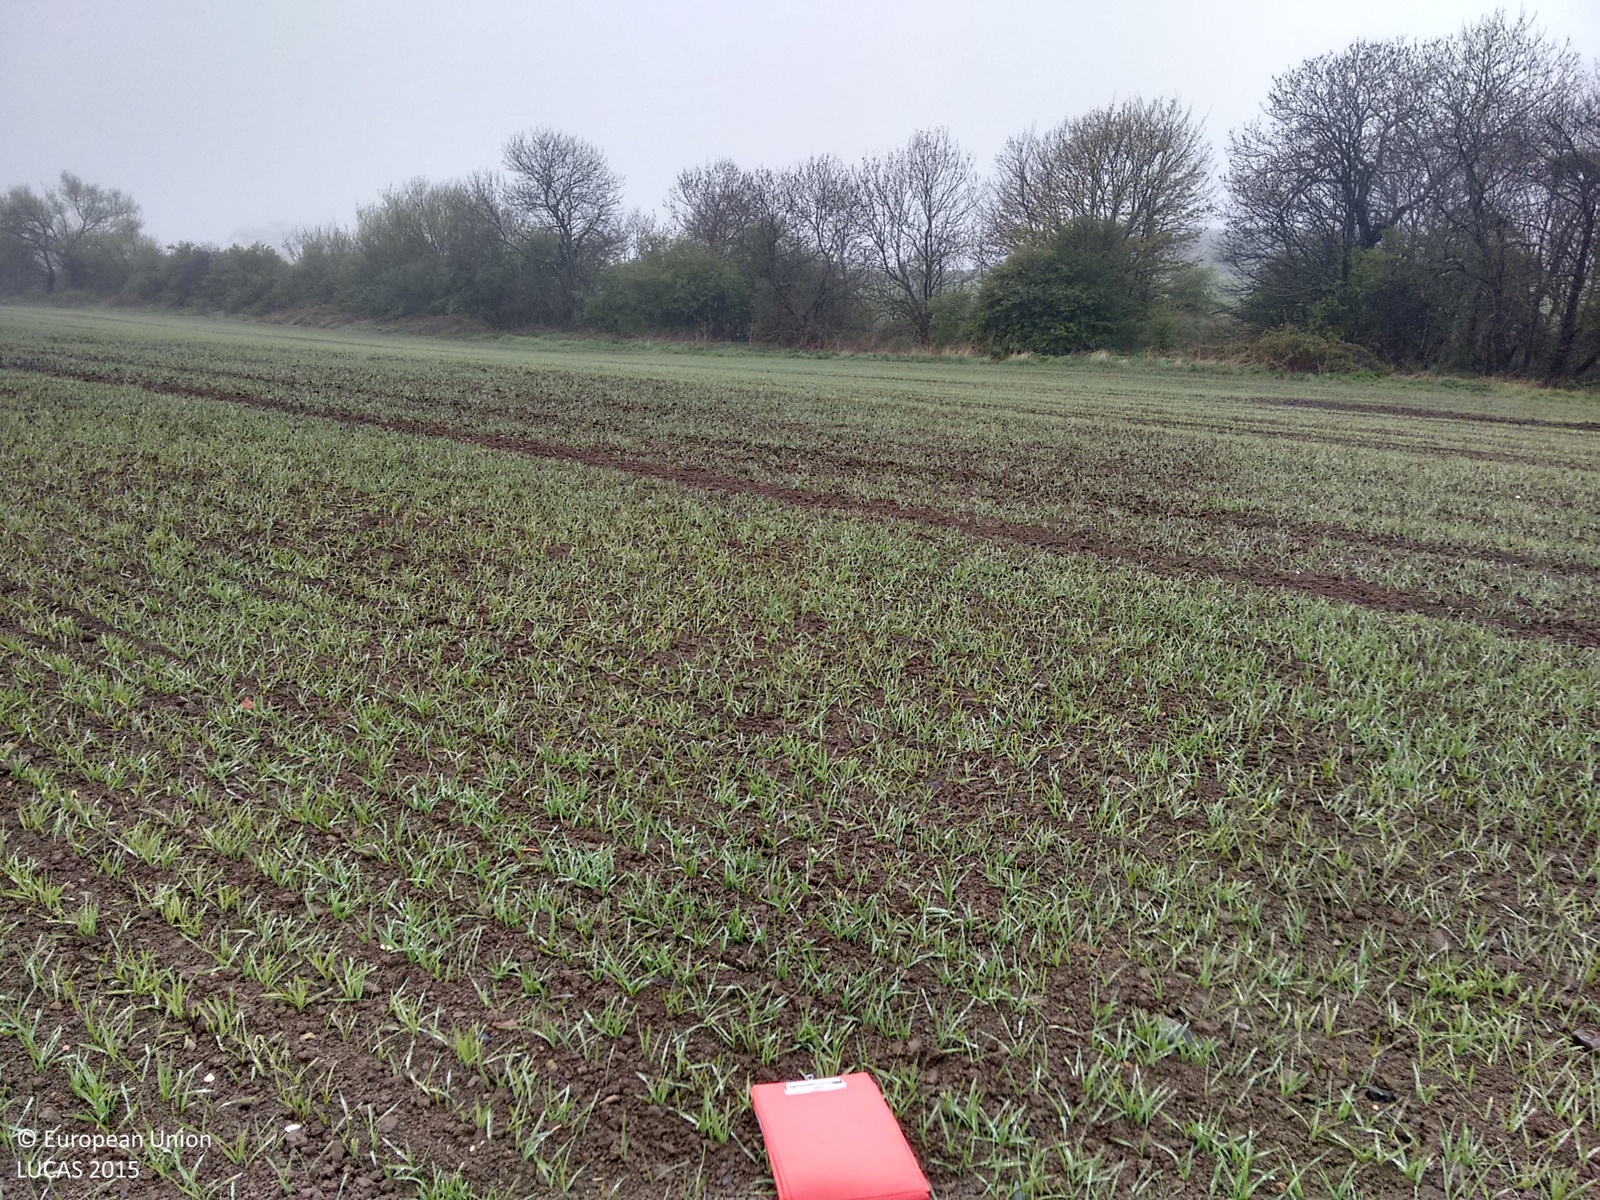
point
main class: Cropland
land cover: Common wheat
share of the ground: > 75 %
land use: Agriculture (excluding fallow land and kitchen gardens)
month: May
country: GB
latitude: 55.2082
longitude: -1.5664
